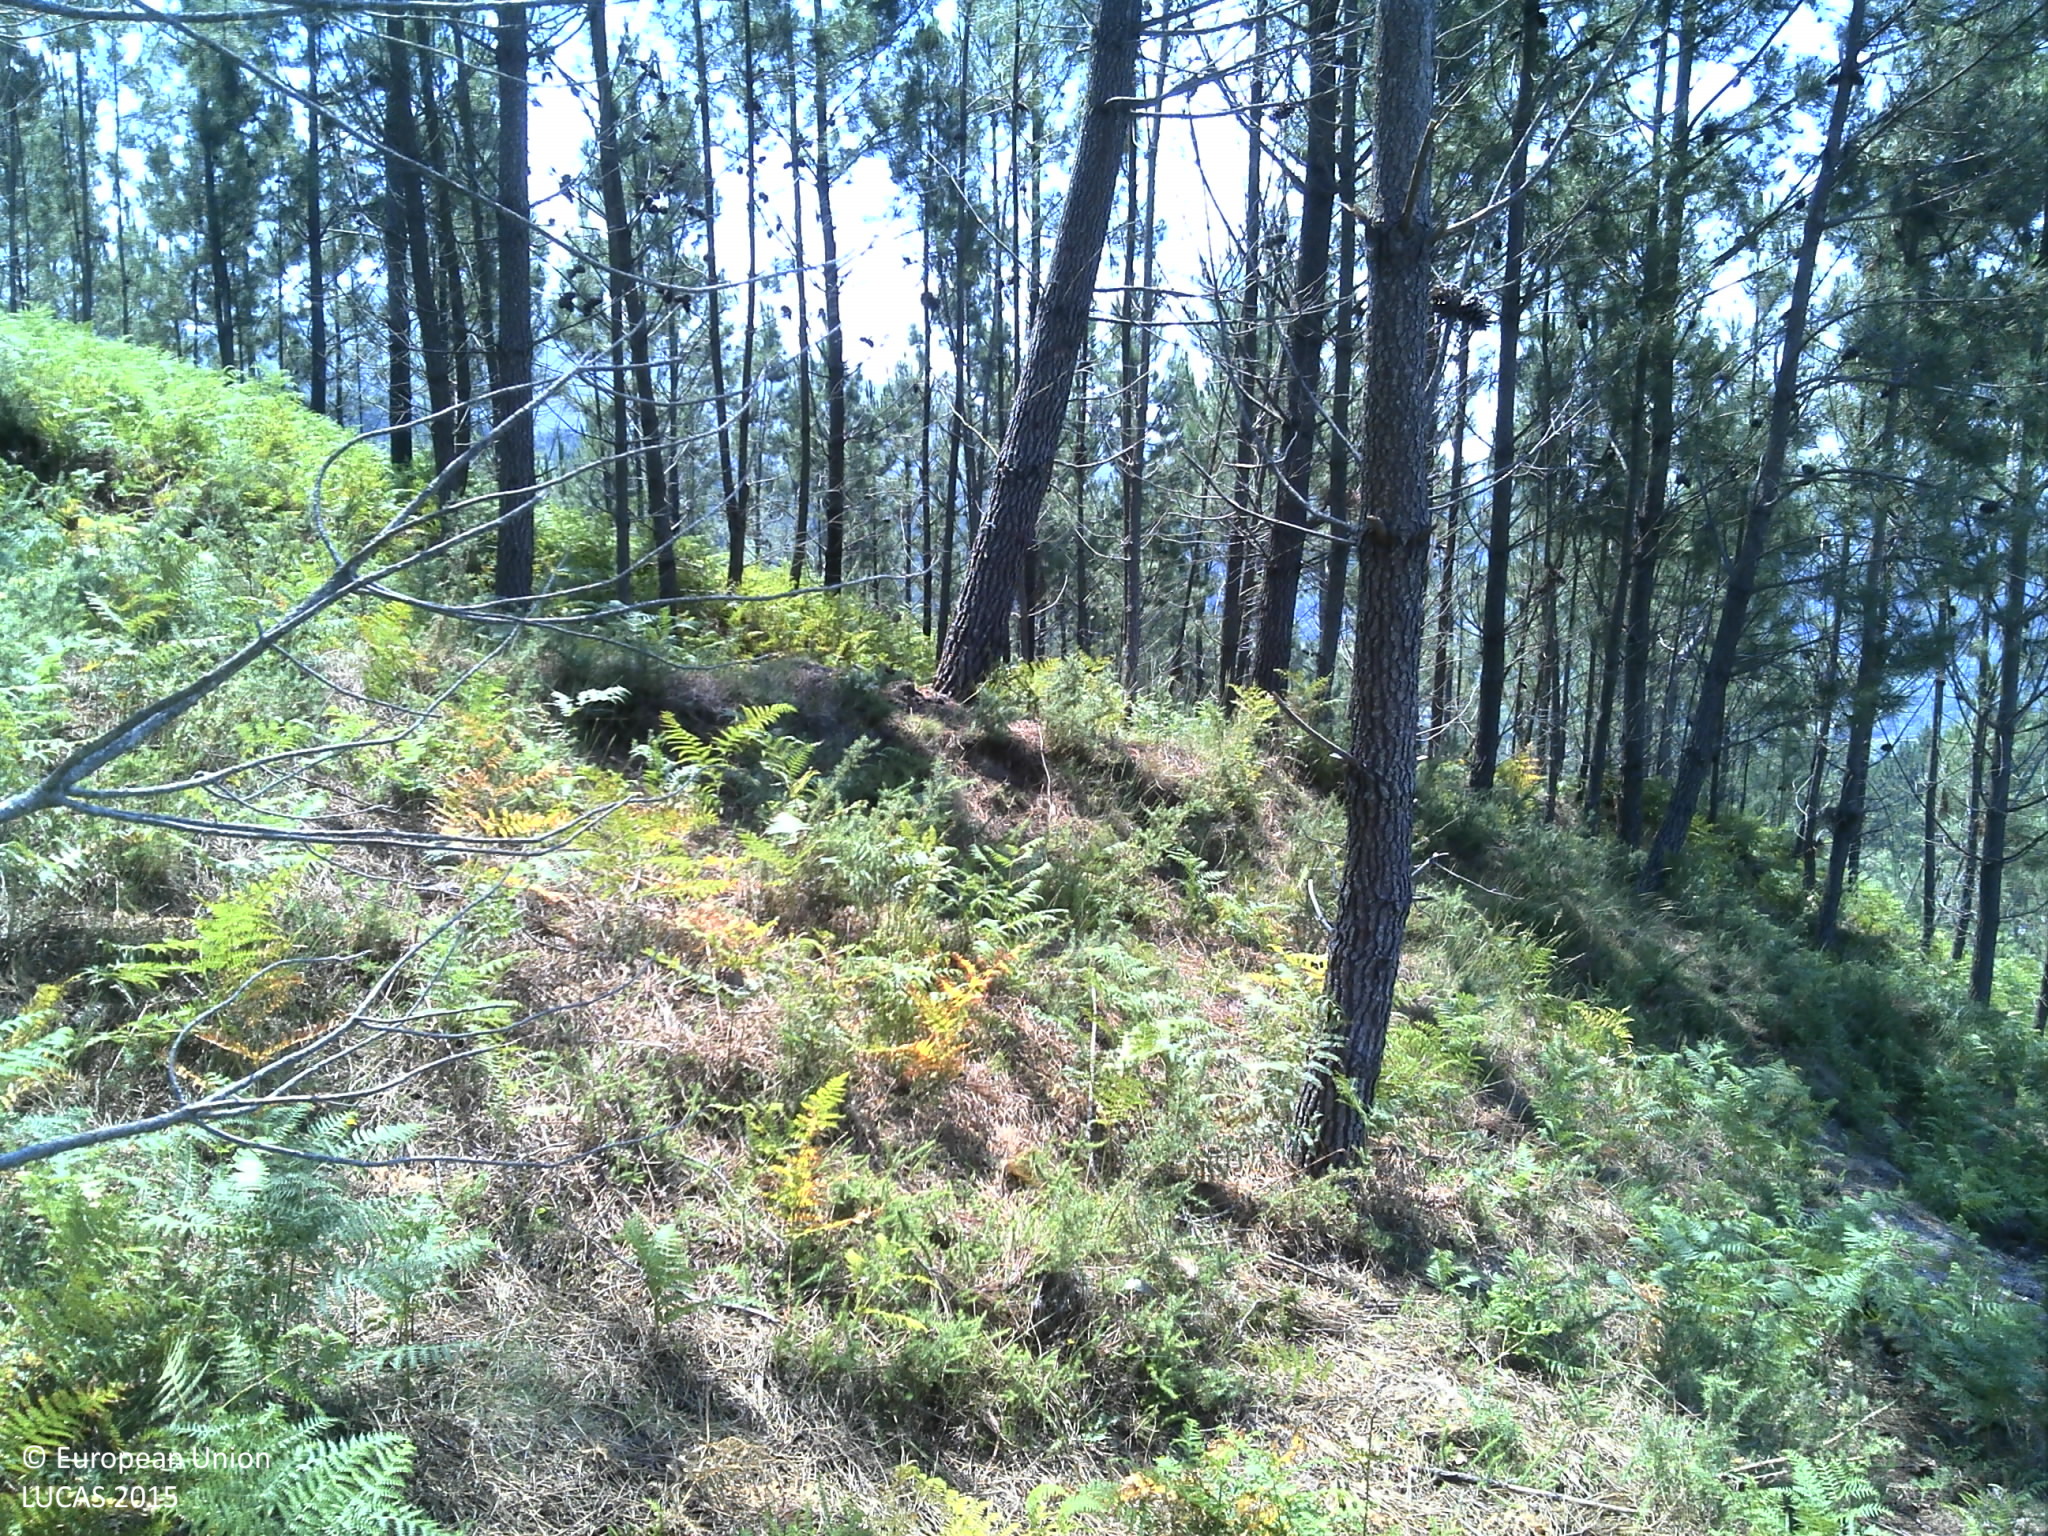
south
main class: Woodland
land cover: Pine dominated coniferous woodland
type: coniferous forest of the mediterranean region
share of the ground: 25 - 50 %
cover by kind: coniferous forest trees 50 %, consolidated bare surface 30 %, shrubs 20 %
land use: Forestry
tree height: > 5 m
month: June
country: PT
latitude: 41.9467
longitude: -8.4108
